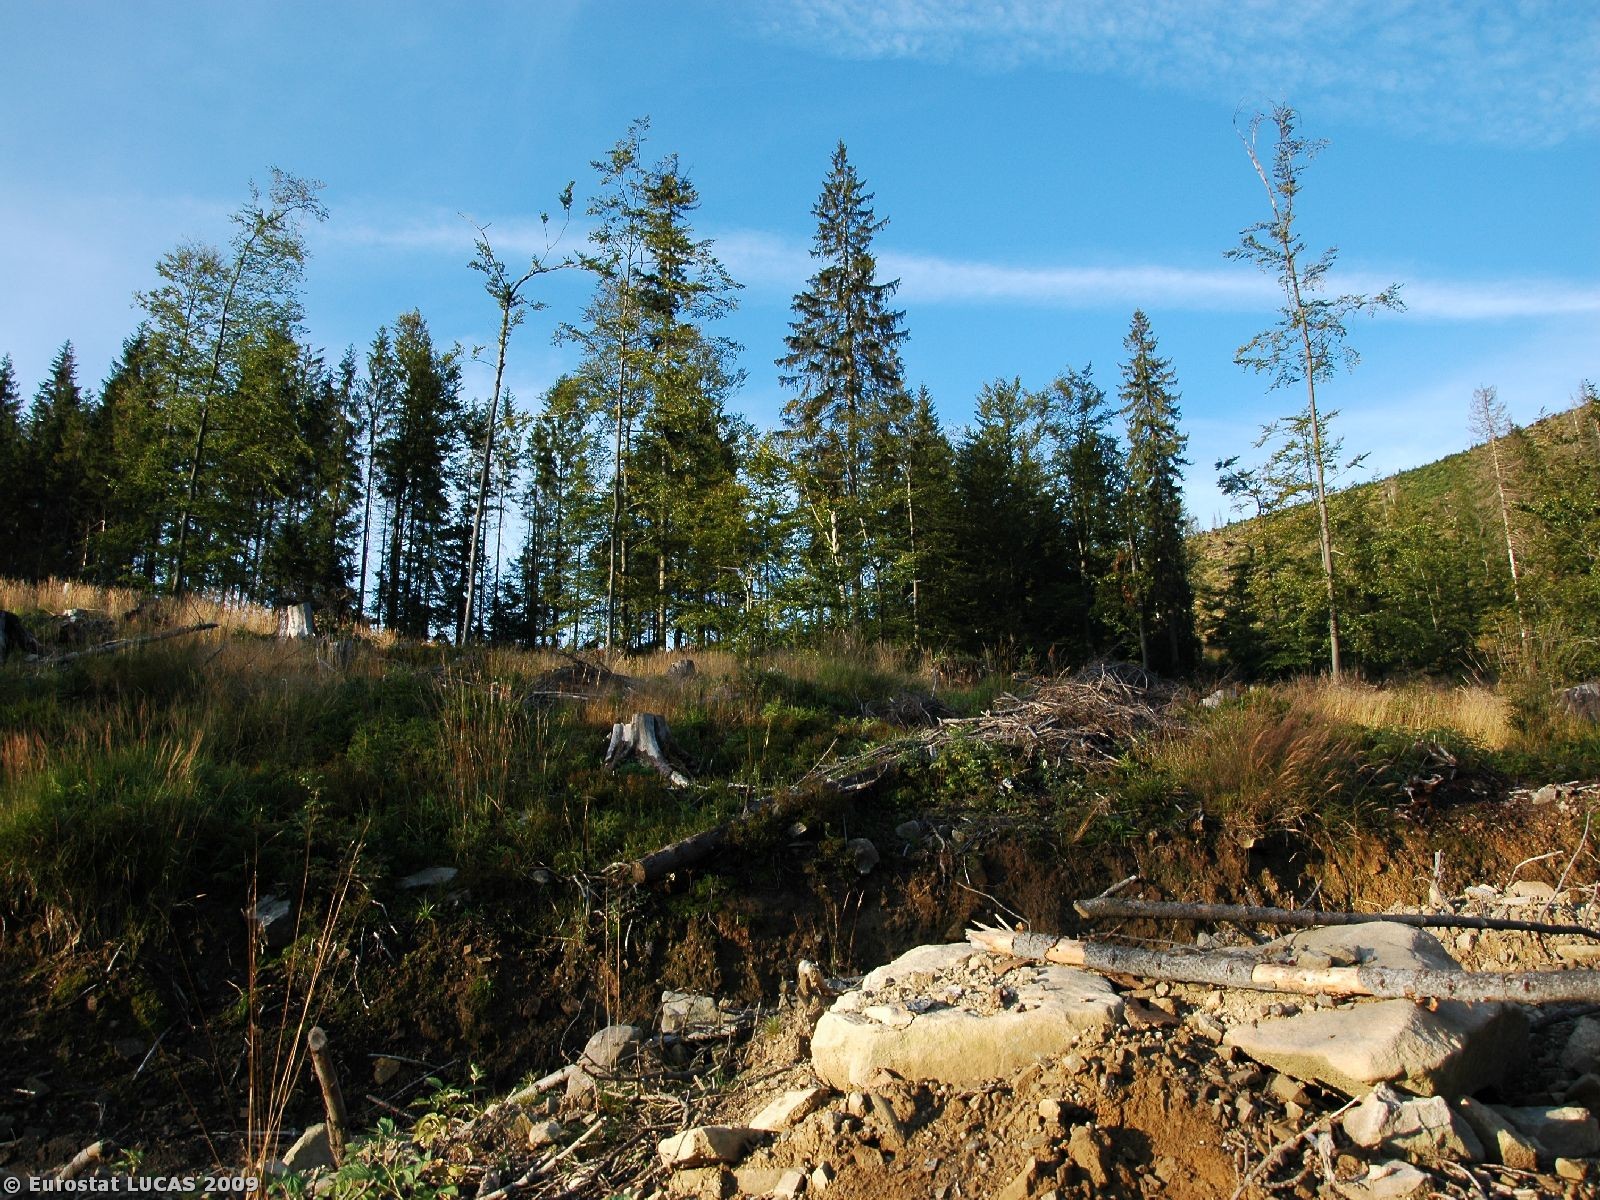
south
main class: Bare land
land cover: Bare land
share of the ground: > 75 %
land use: Forestry
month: September
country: PL
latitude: 49.6459
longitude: 19.0108
